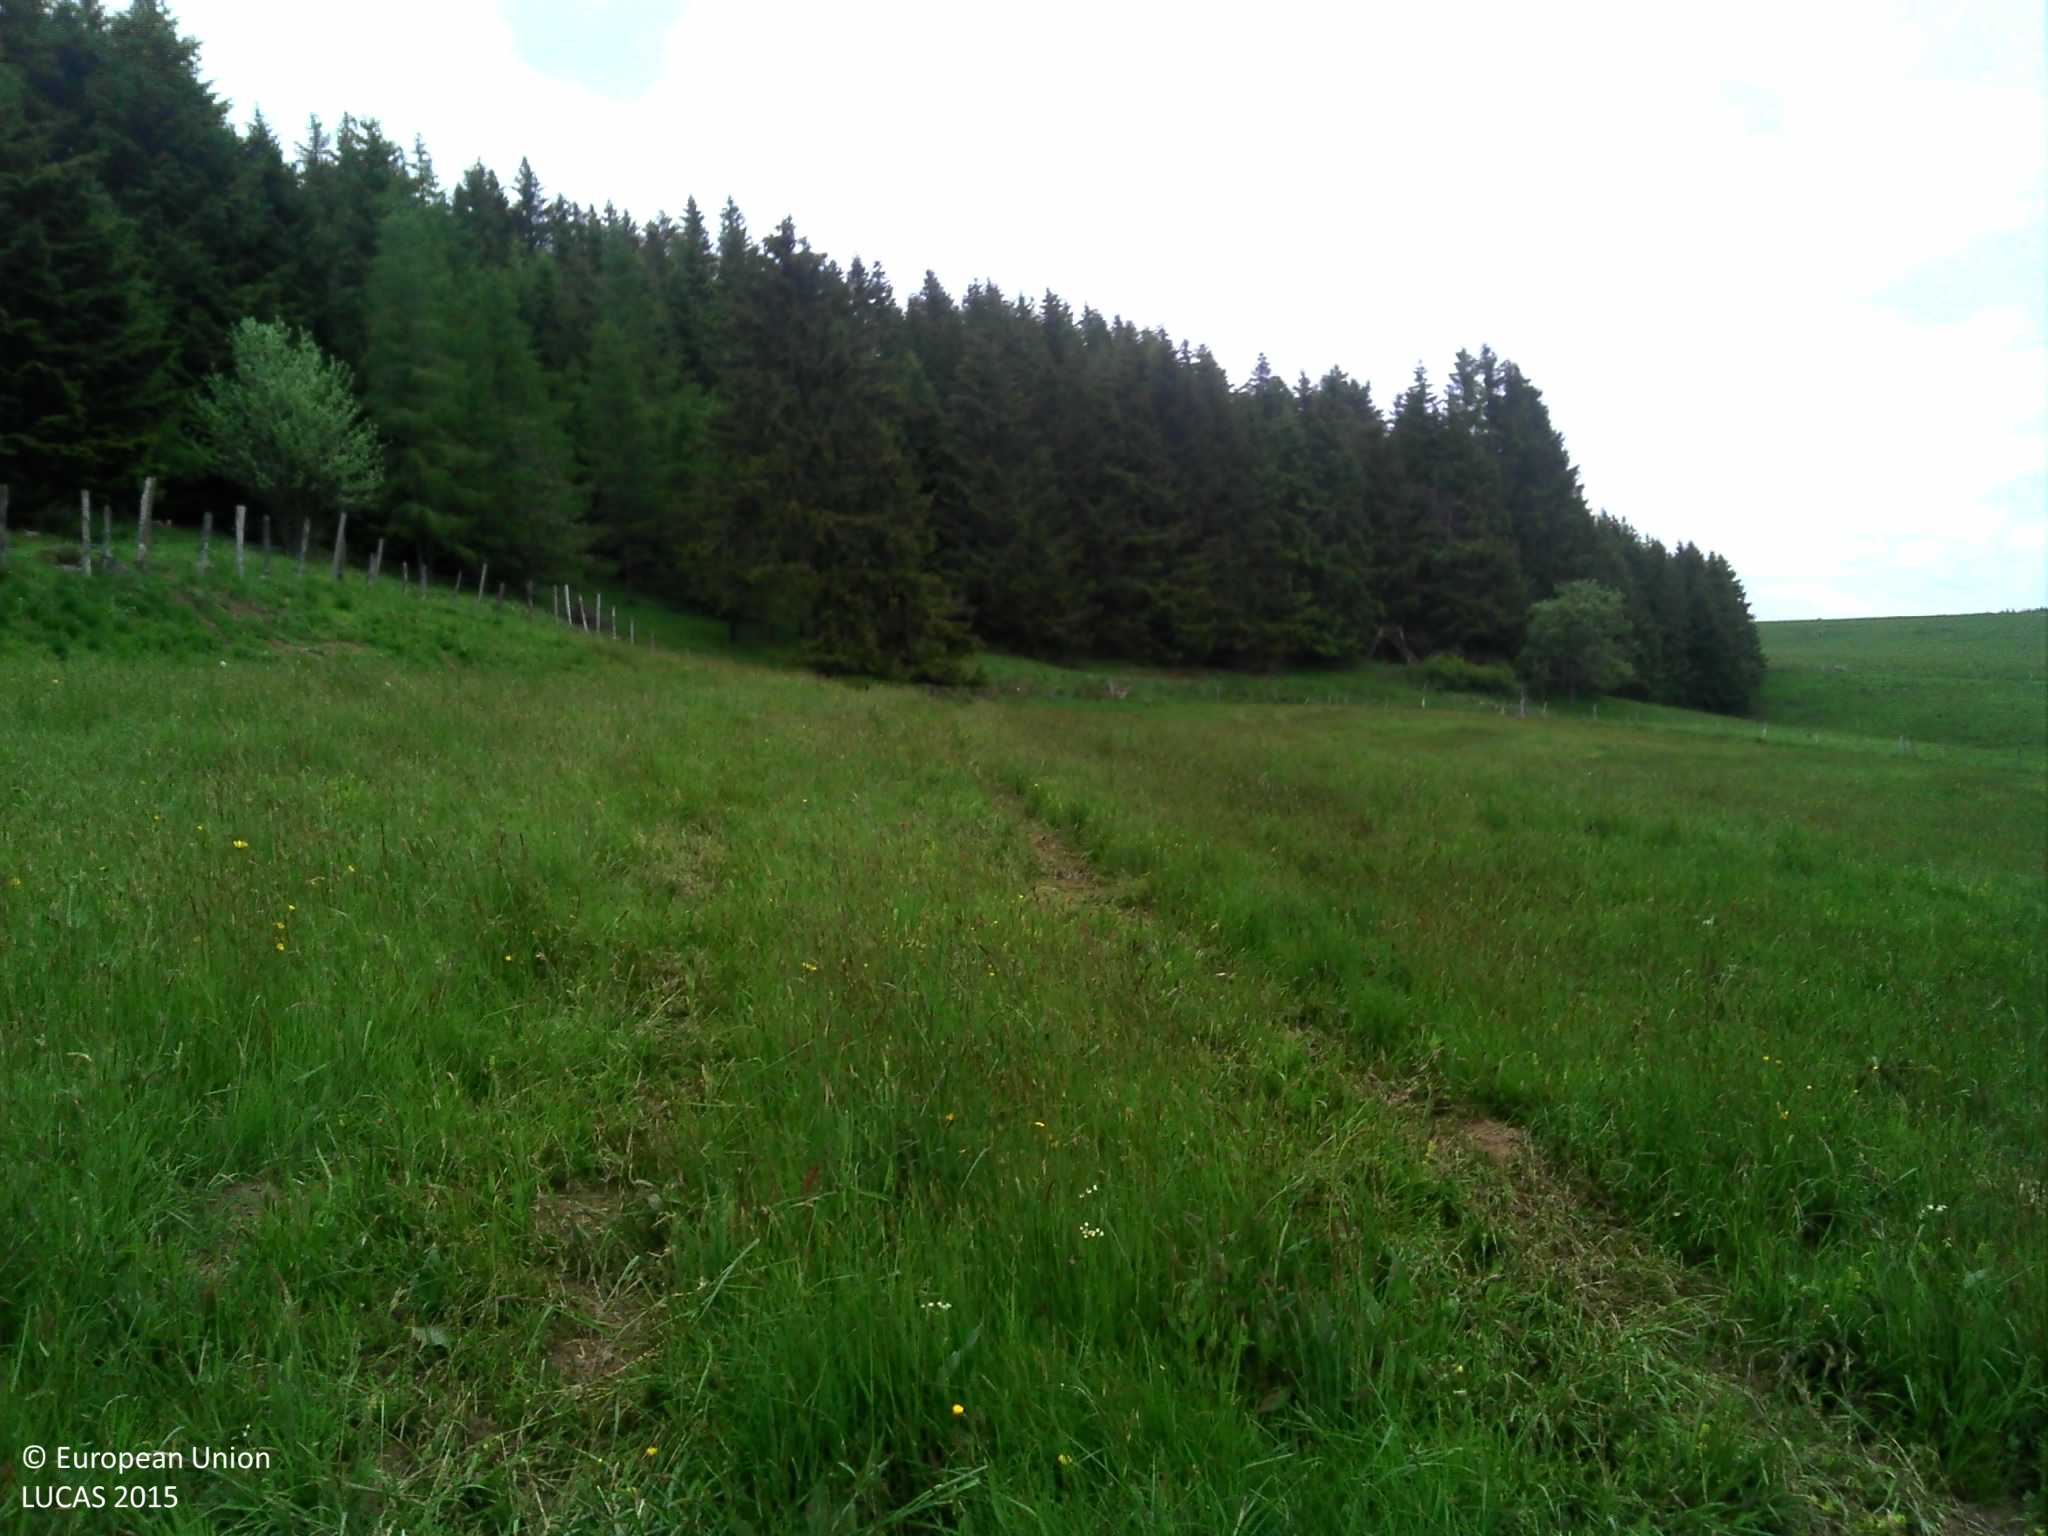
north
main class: Grassland
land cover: Grassland without tree/shrub cover
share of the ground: > 75 %
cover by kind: herbaceous plants 100 %
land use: Agriculture (excluding fallow land and kitchen gardens)
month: May
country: FR
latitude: 45.2508
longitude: 2.9550
